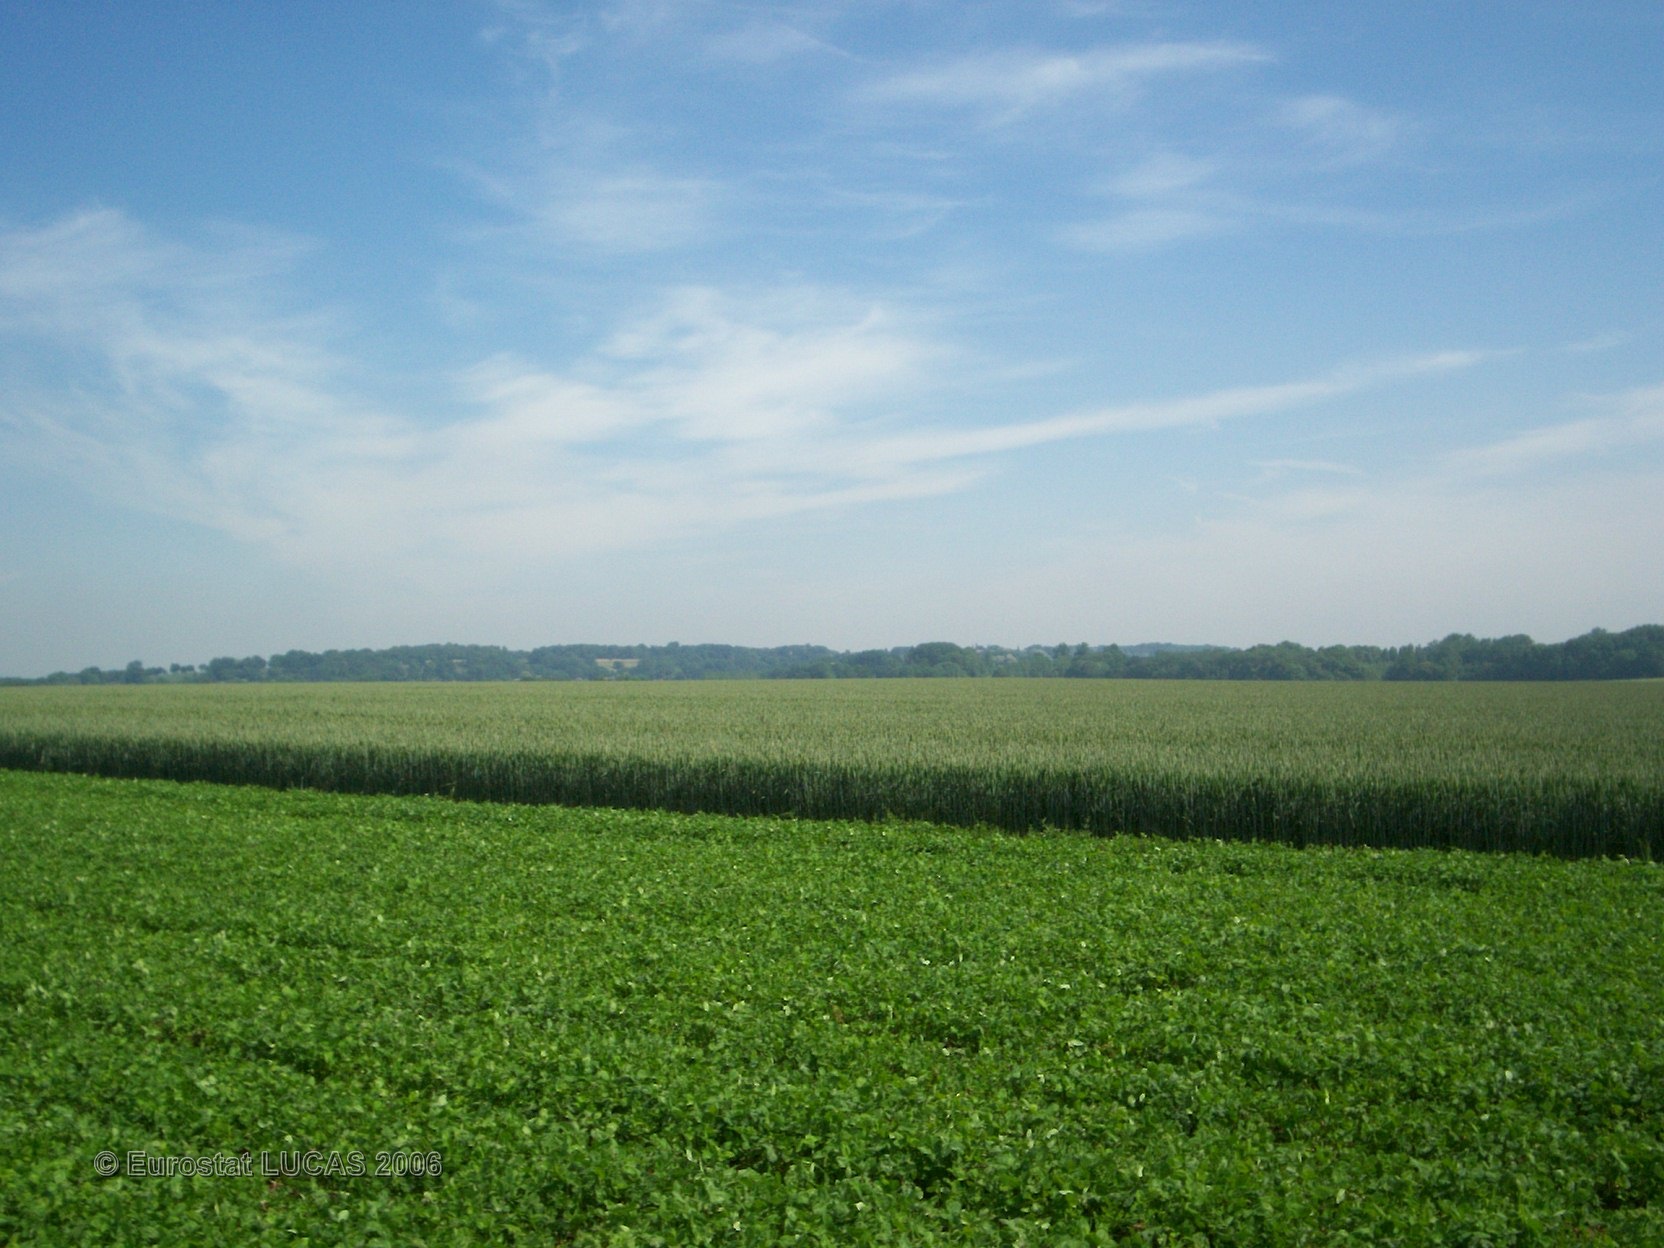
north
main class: Cropland
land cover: Clovers
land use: Agriculture (excluding fallow land and kitchen gardens)
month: June
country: FR
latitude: 49.5889
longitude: 2.6989
